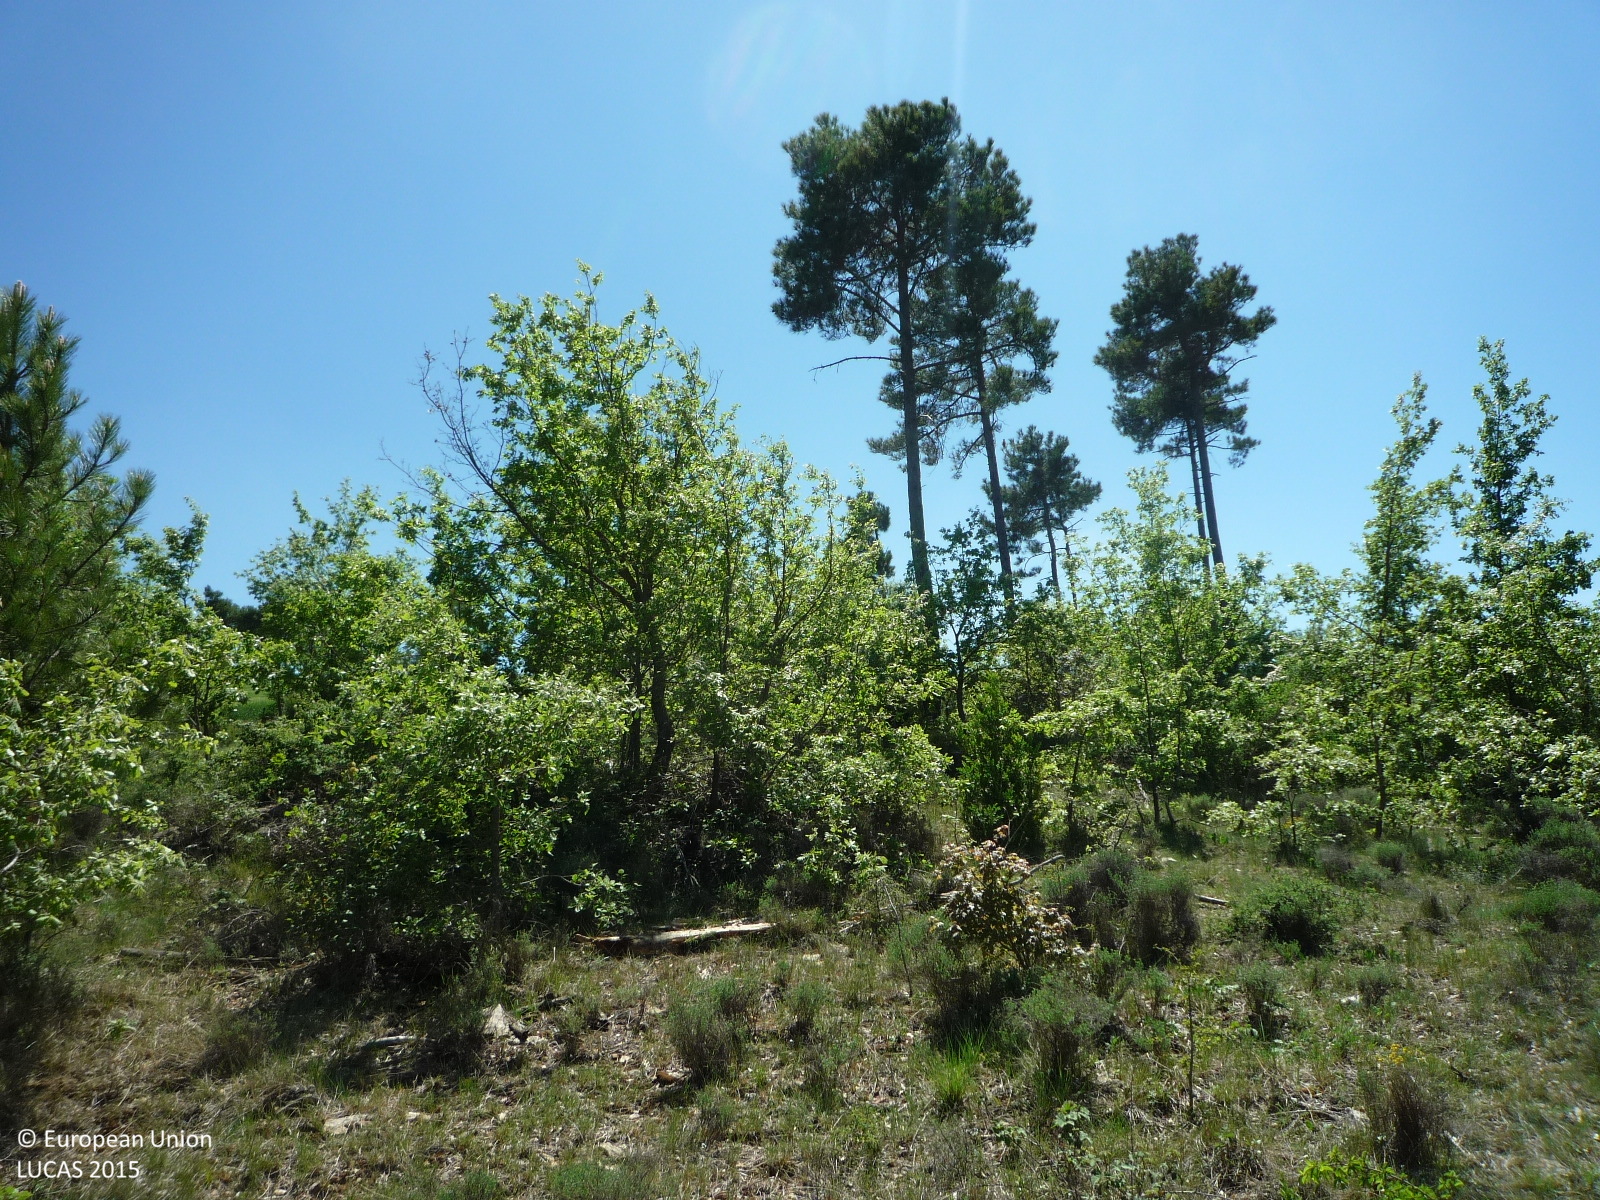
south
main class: Woodland
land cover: Other mixed woodland
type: broadleaved evergreen forest
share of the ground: > 75 %
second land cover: Spontaneously vegetated surfaces
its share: 25 - 50 %
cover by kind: herbaceous plants 40 %, broadleaved forest trees 35 %, coniferous forest trees 25 %
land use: Forestry
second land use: Agriculture (excluding fallow land and kitchen gardens)
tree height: < 5 m
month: May
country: ES
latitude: 41.7965
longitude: 1.6020
